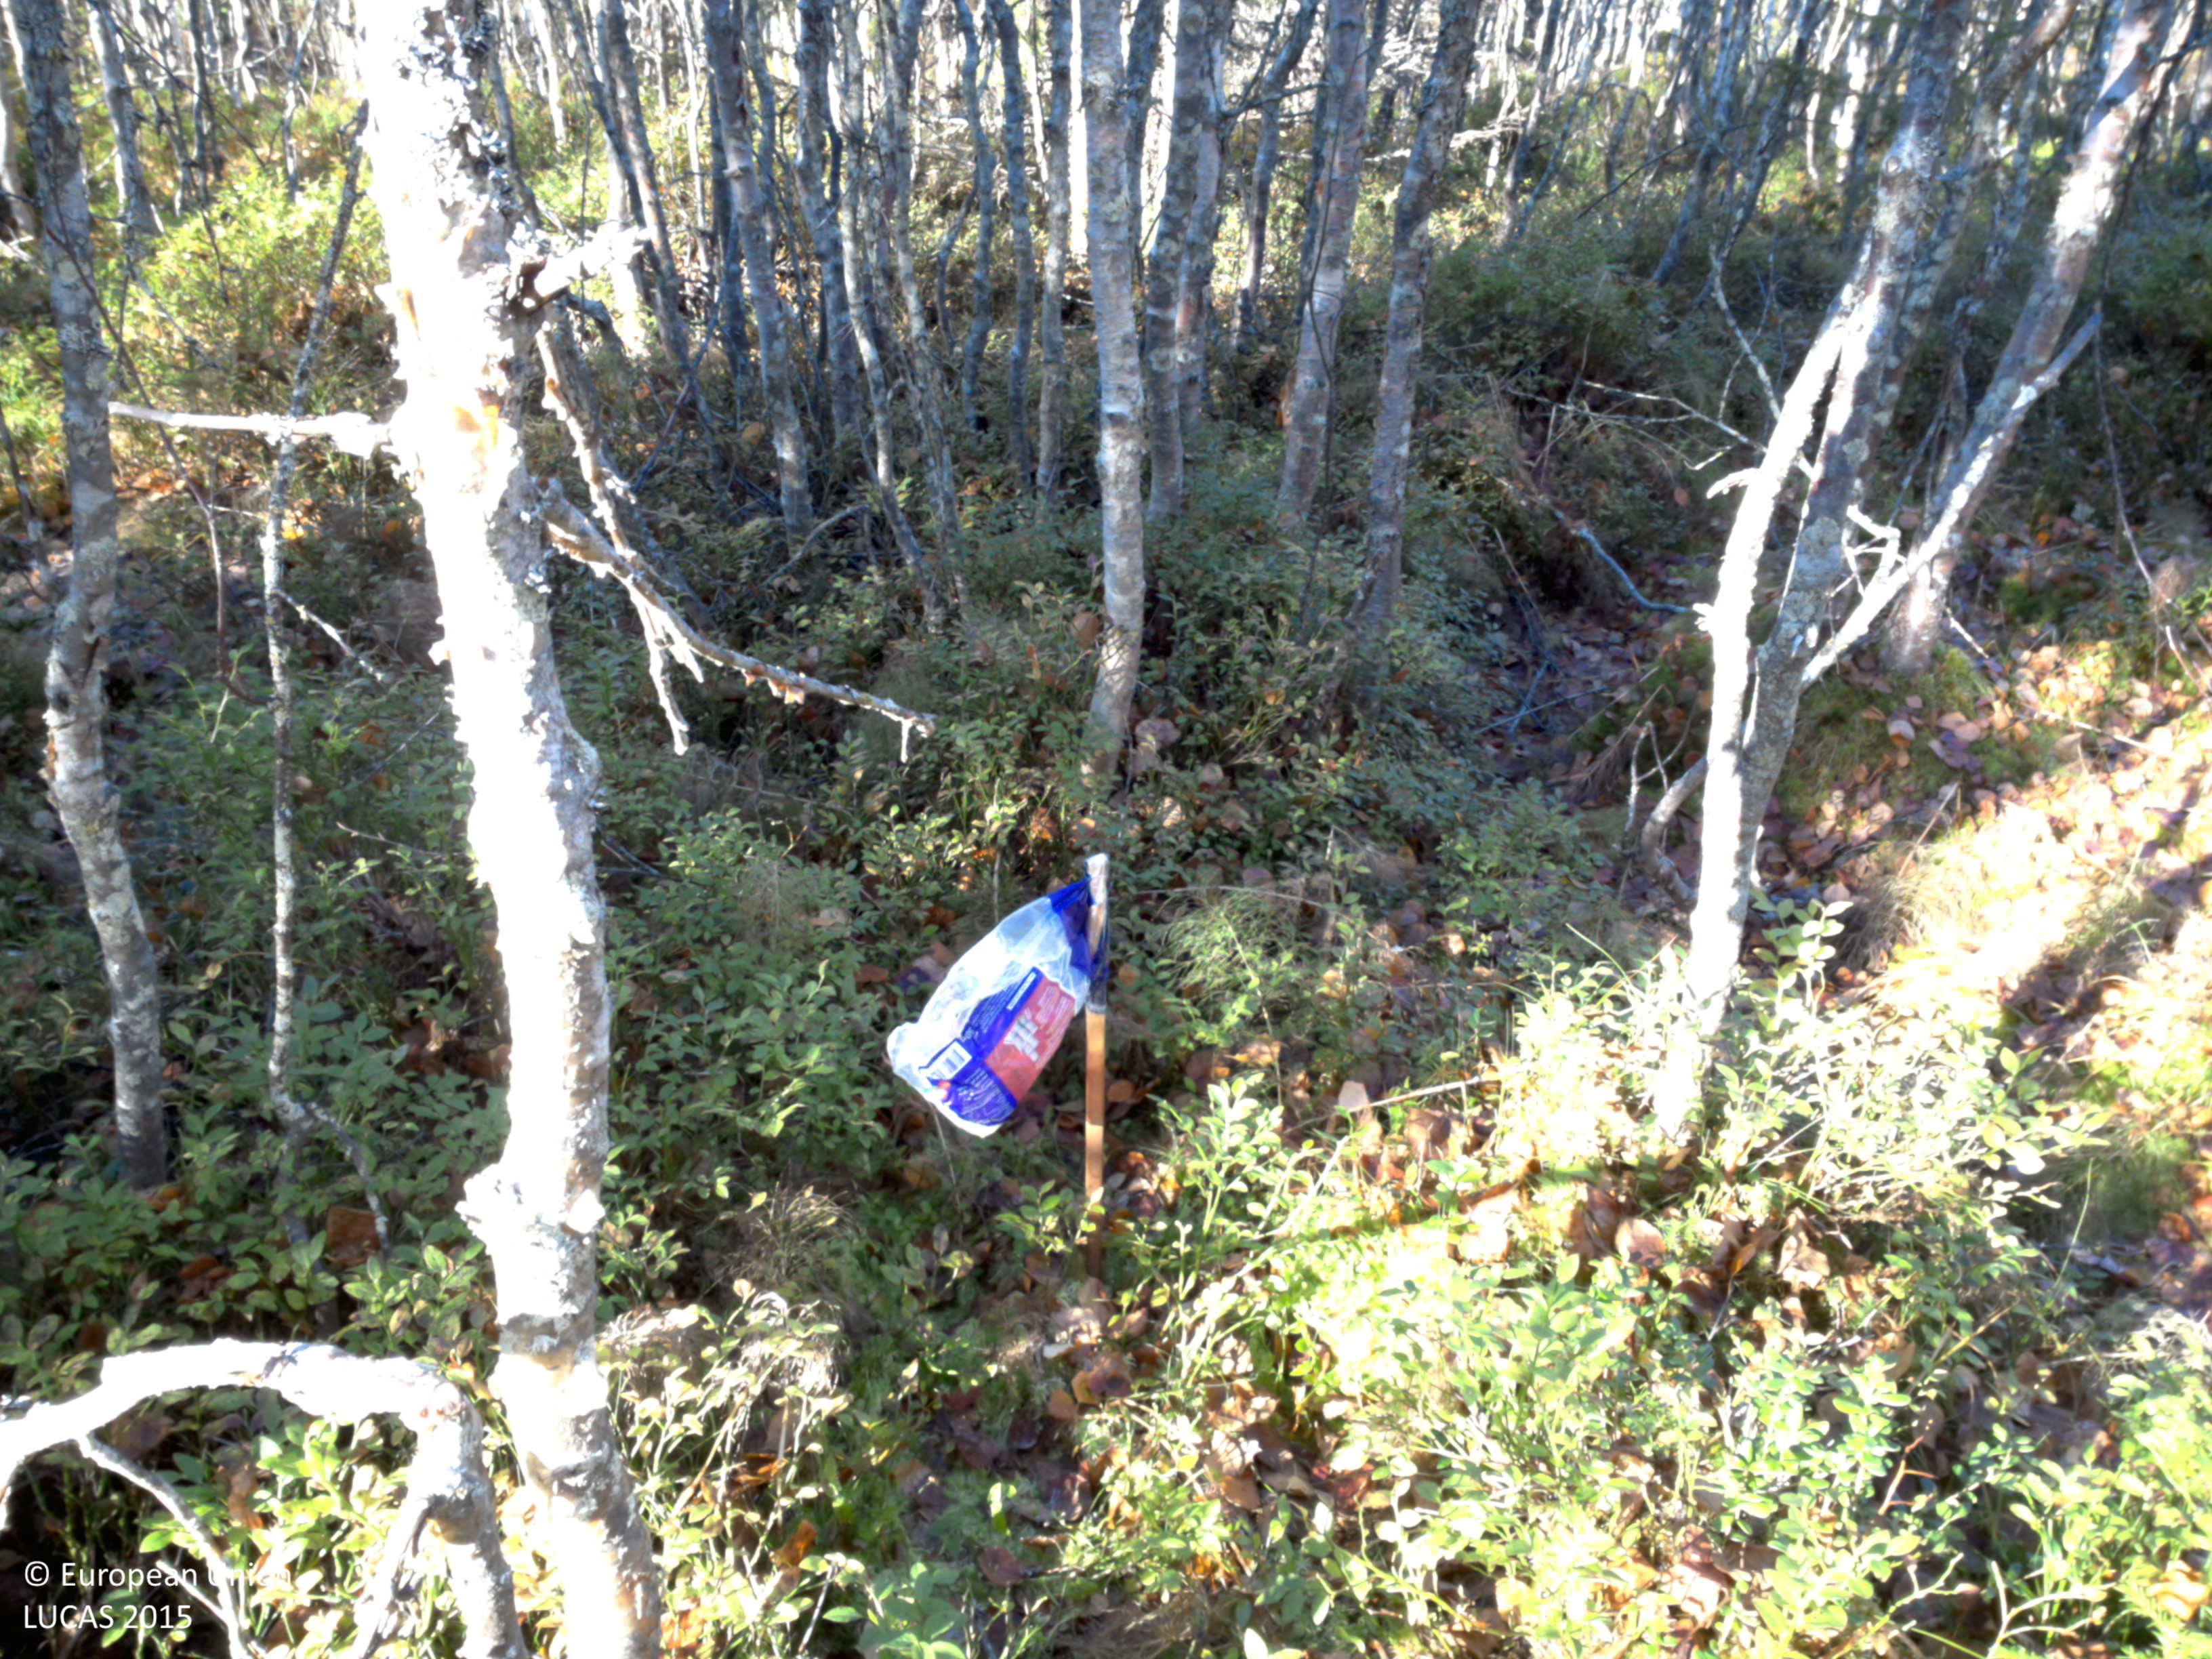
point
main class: Woodland
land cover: Spruce dominated mixed woodland
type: boreal forest
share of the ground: > 75 %
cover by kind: broadleaved forest trees 50 %, coniferous forest trees 30 %, shrubs 10 %, herbaceous plants 5 %, lichens and mosses 5 %
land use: Forestry
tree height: > 5 m
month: October
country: SE
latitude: 64.6076
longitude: 17.7625
